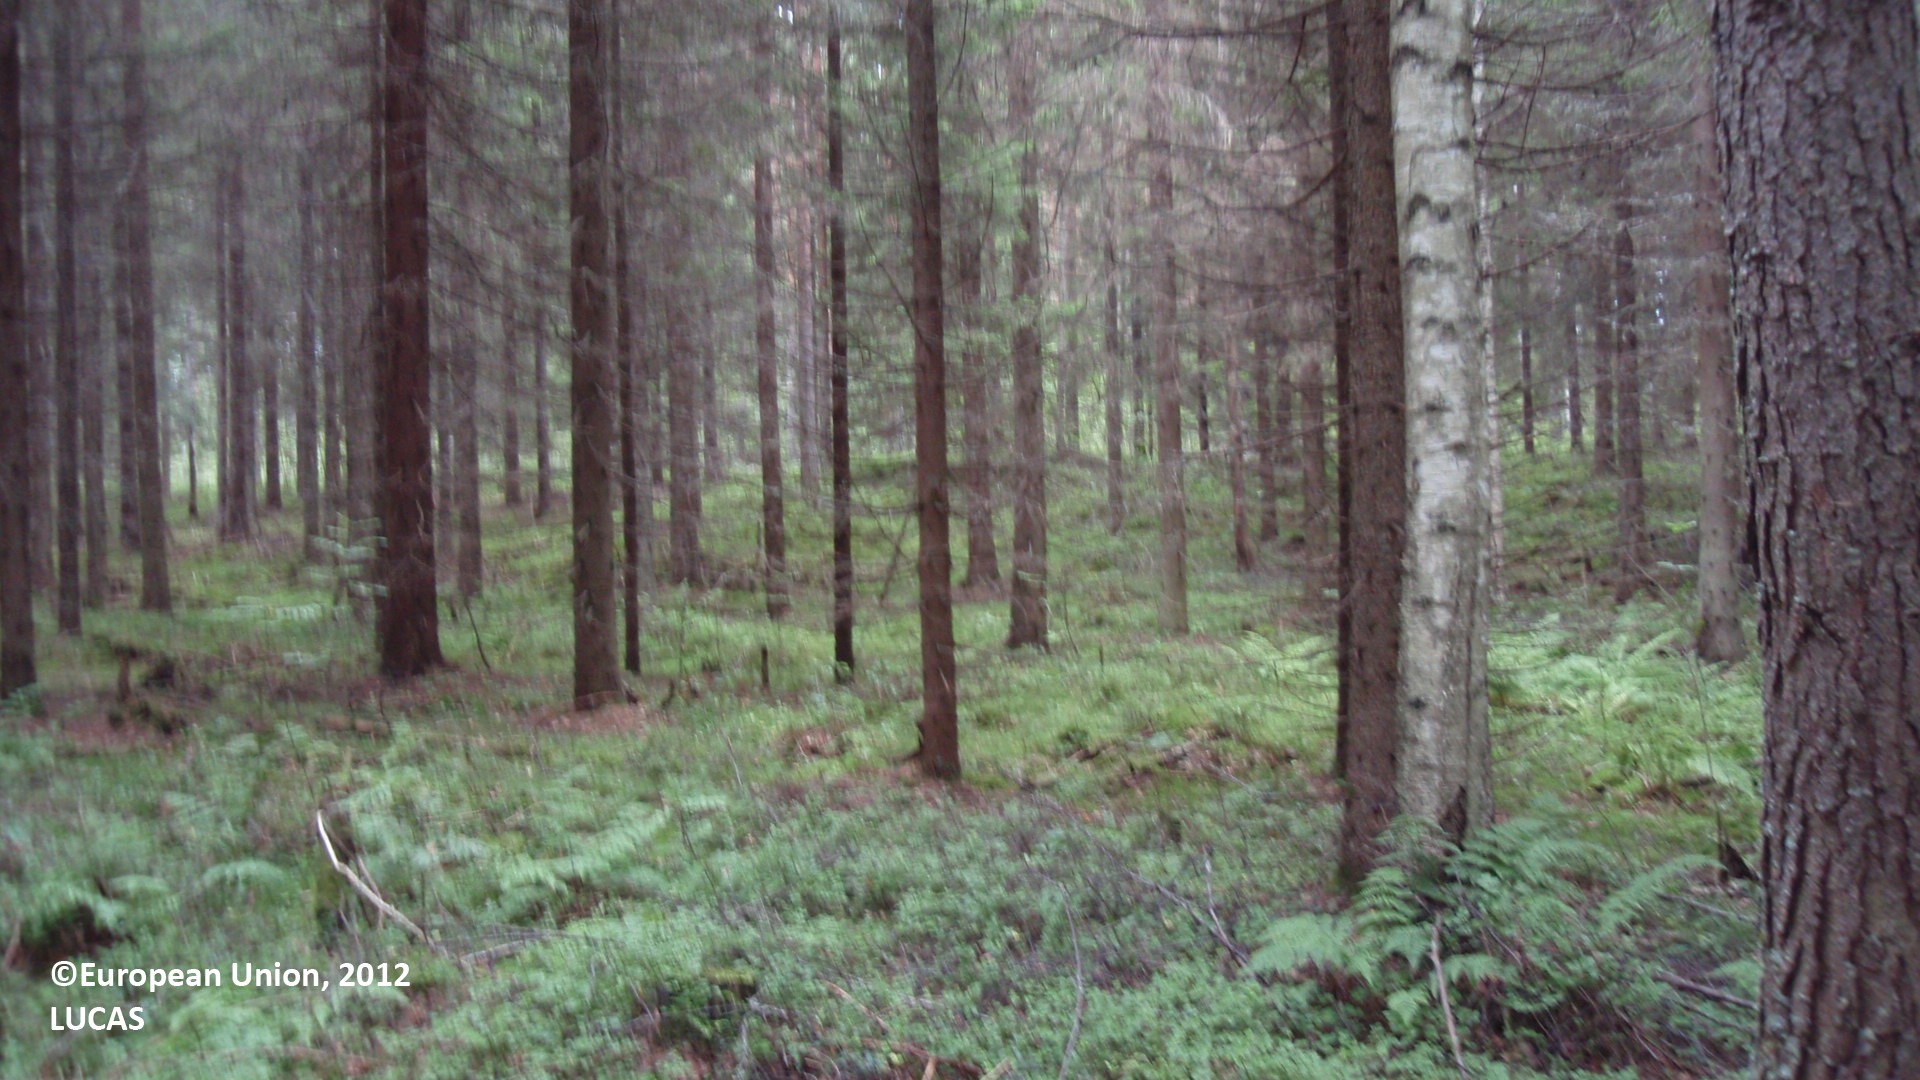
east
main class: Woodland
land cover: Spruce dominated mixed woodland
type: boreal forest
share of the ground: 50 - 75 %
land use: Forestry
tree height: > 5 m
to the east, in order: Spruce dominated mixed woodland; Spruce dominated coniferous woodland; Pine dominated mixed woodland; Shrubland with sparse tree cover; Broadleaved woodland
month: August
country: FI
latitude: 61.1930
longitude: 27.7315
